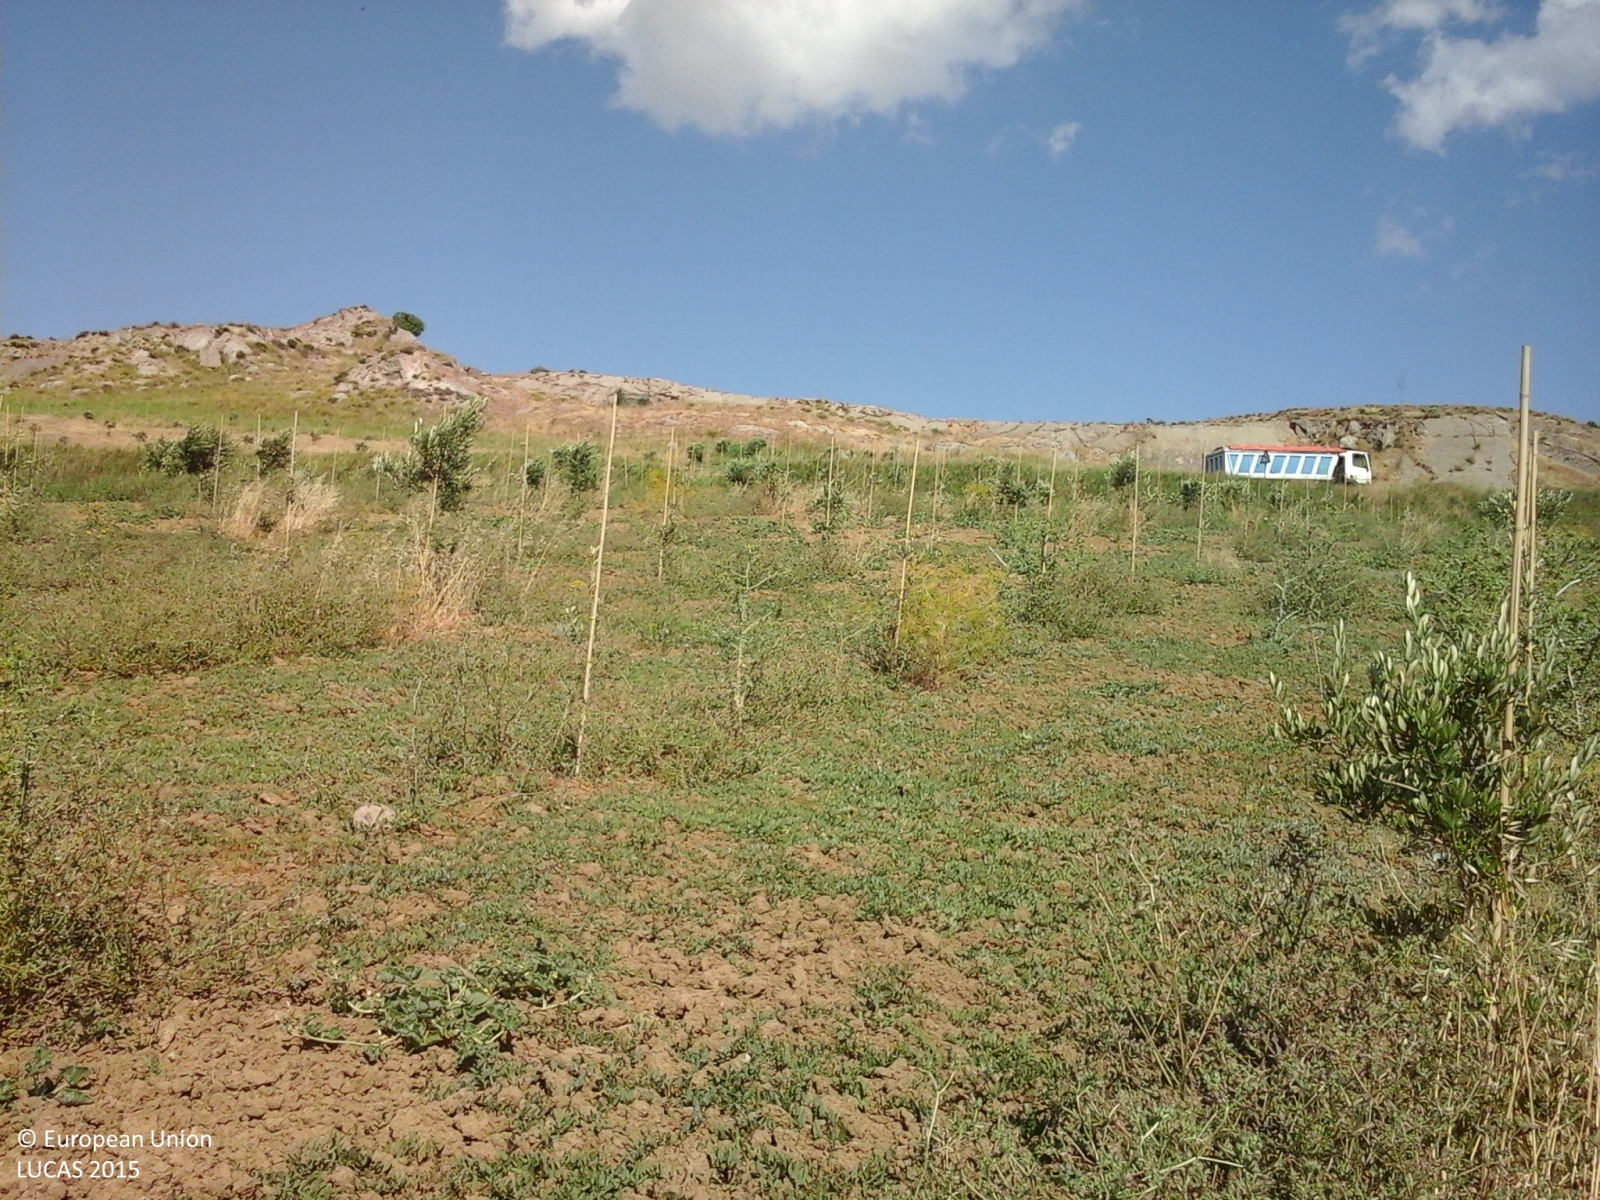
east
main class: Cropland
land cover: Durum wheat
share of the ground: > 75 %
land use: Agriculture (excluding fallow land and kitchen gardens)
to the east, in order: Durum wheat; Grass margins; Olive groves; Grass margins; Paved roads, cycling and walking lanes; Artificial constructions; Grass margins; Olive groves; Managed hedges; Olive groves; Rocks and stones
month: June
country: IT
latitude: 37.7069
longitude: 12.7807
